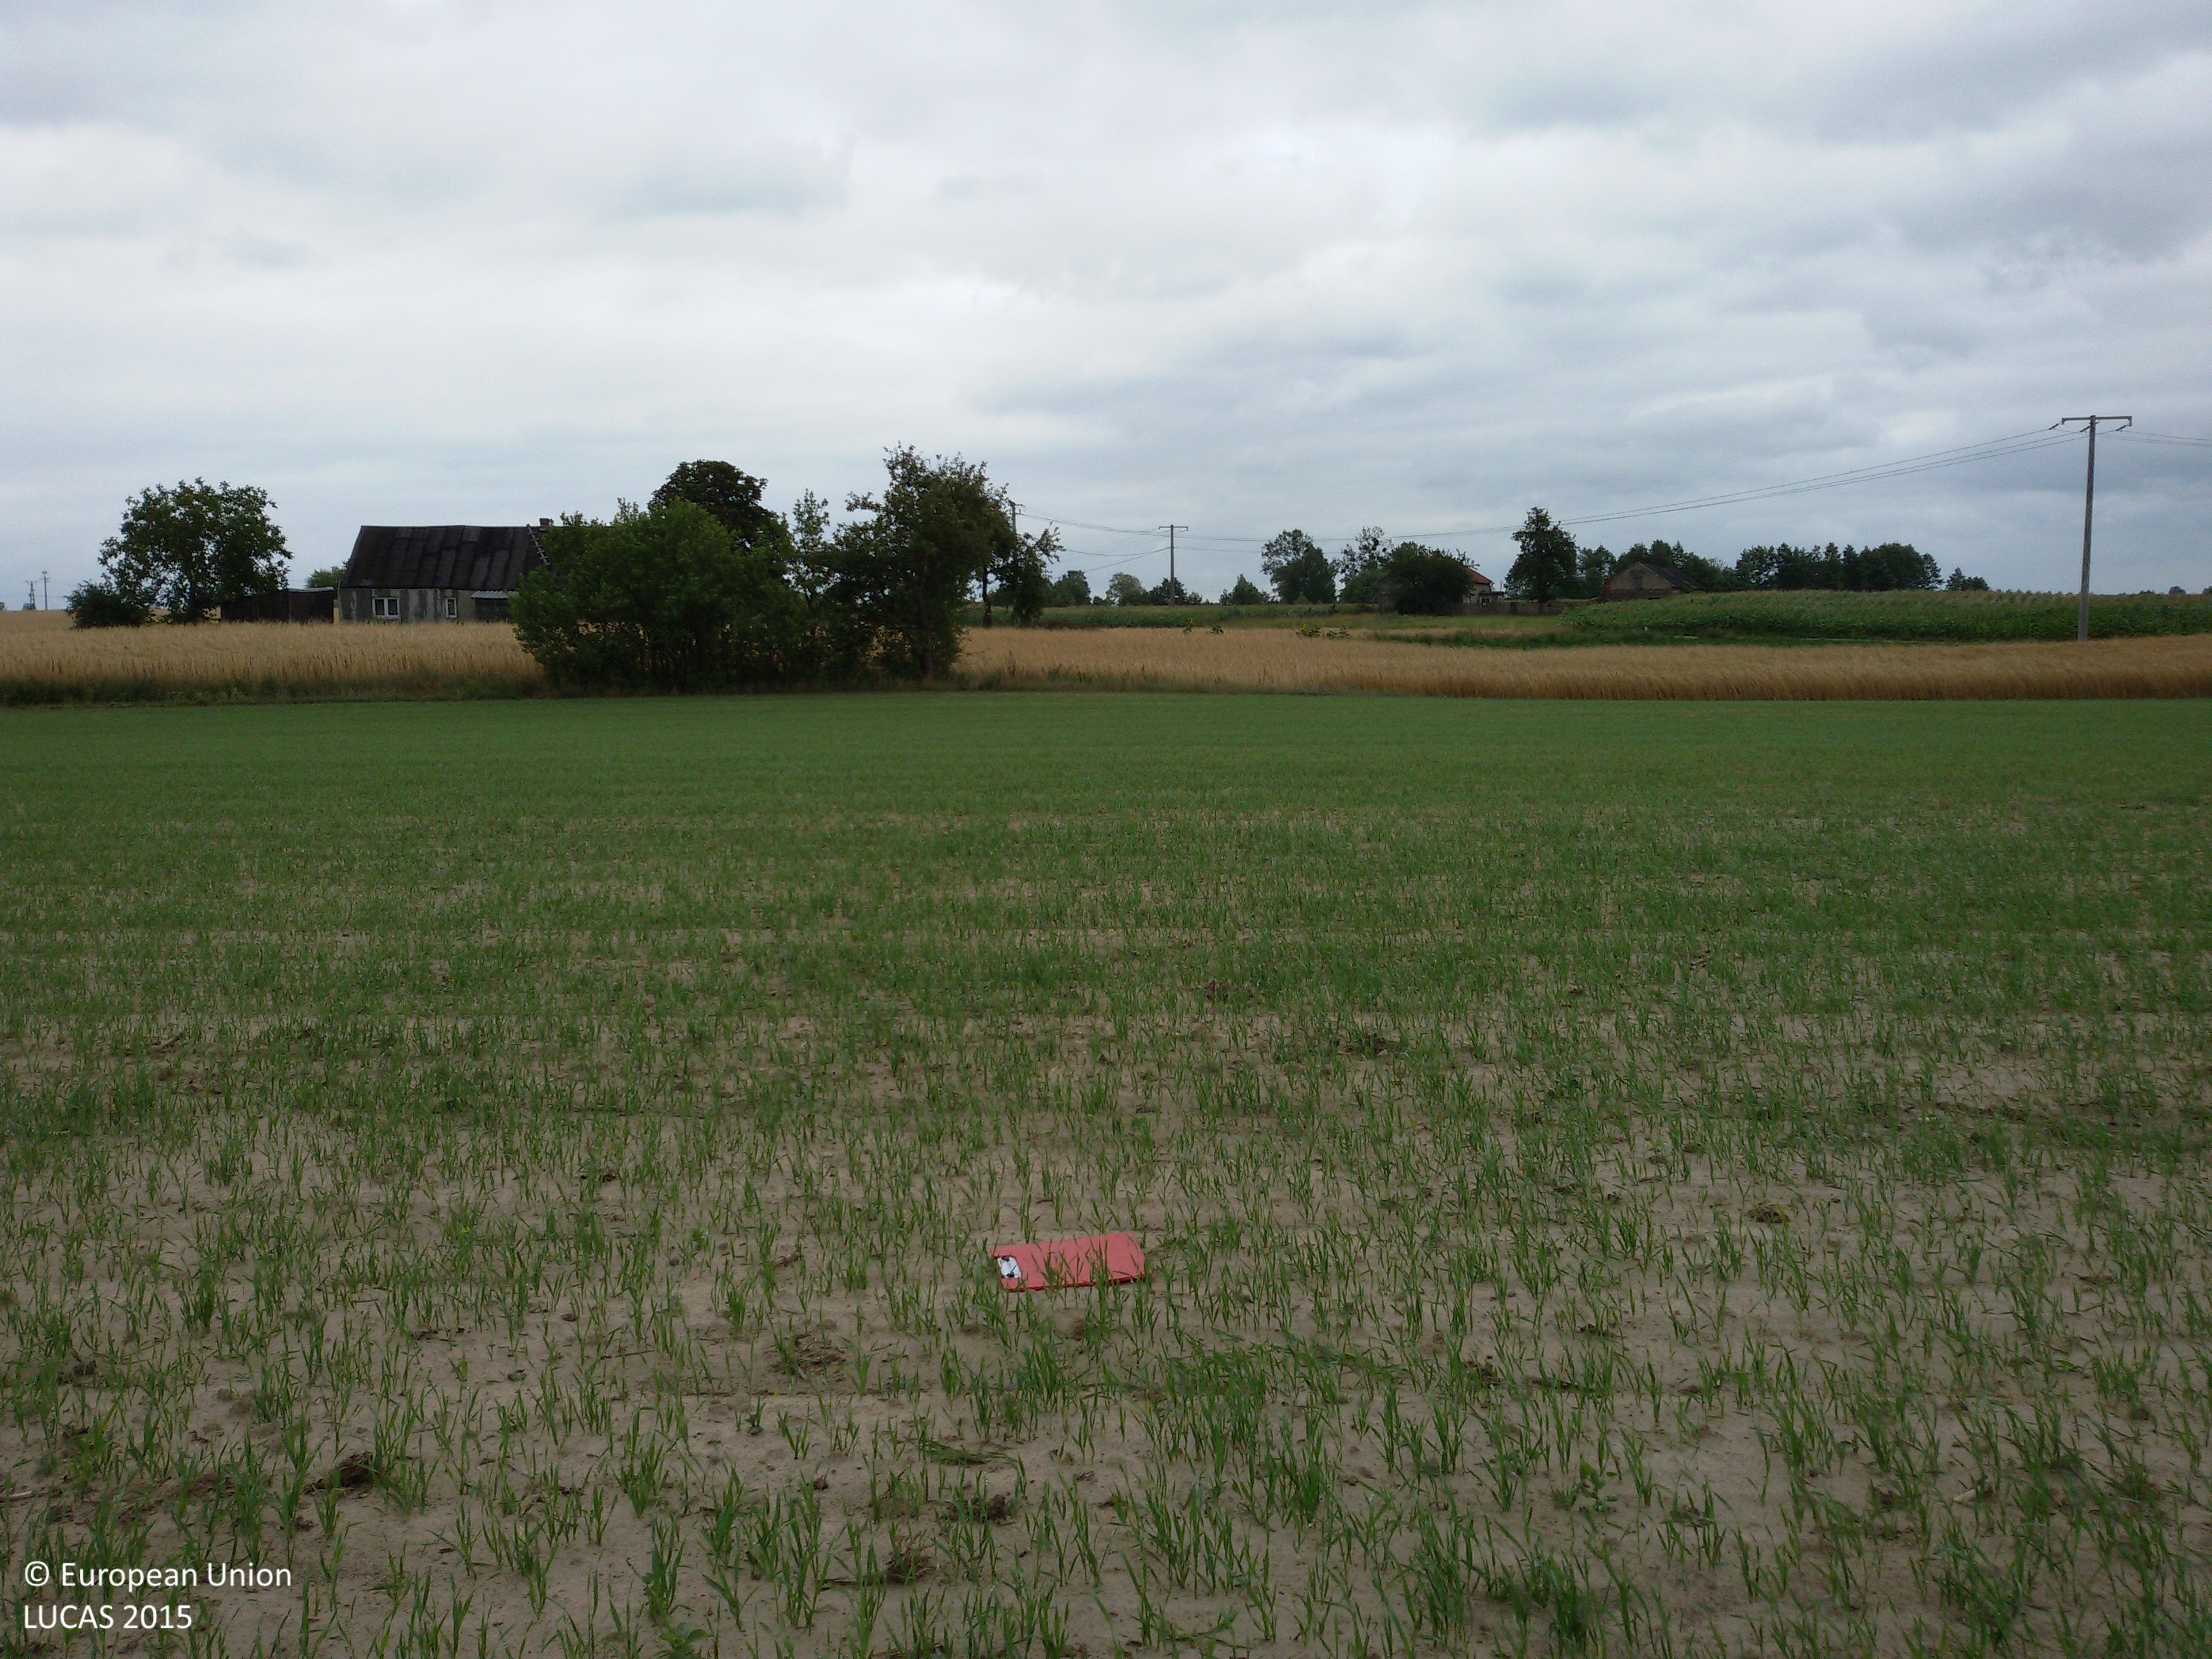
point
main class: Cropland
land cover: Oats
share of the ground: 10 - 25 %
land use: Agriculture (excluding fallow land and kitchen gardens)
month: July
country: PL
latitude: 52.9644
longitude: 19.1506
